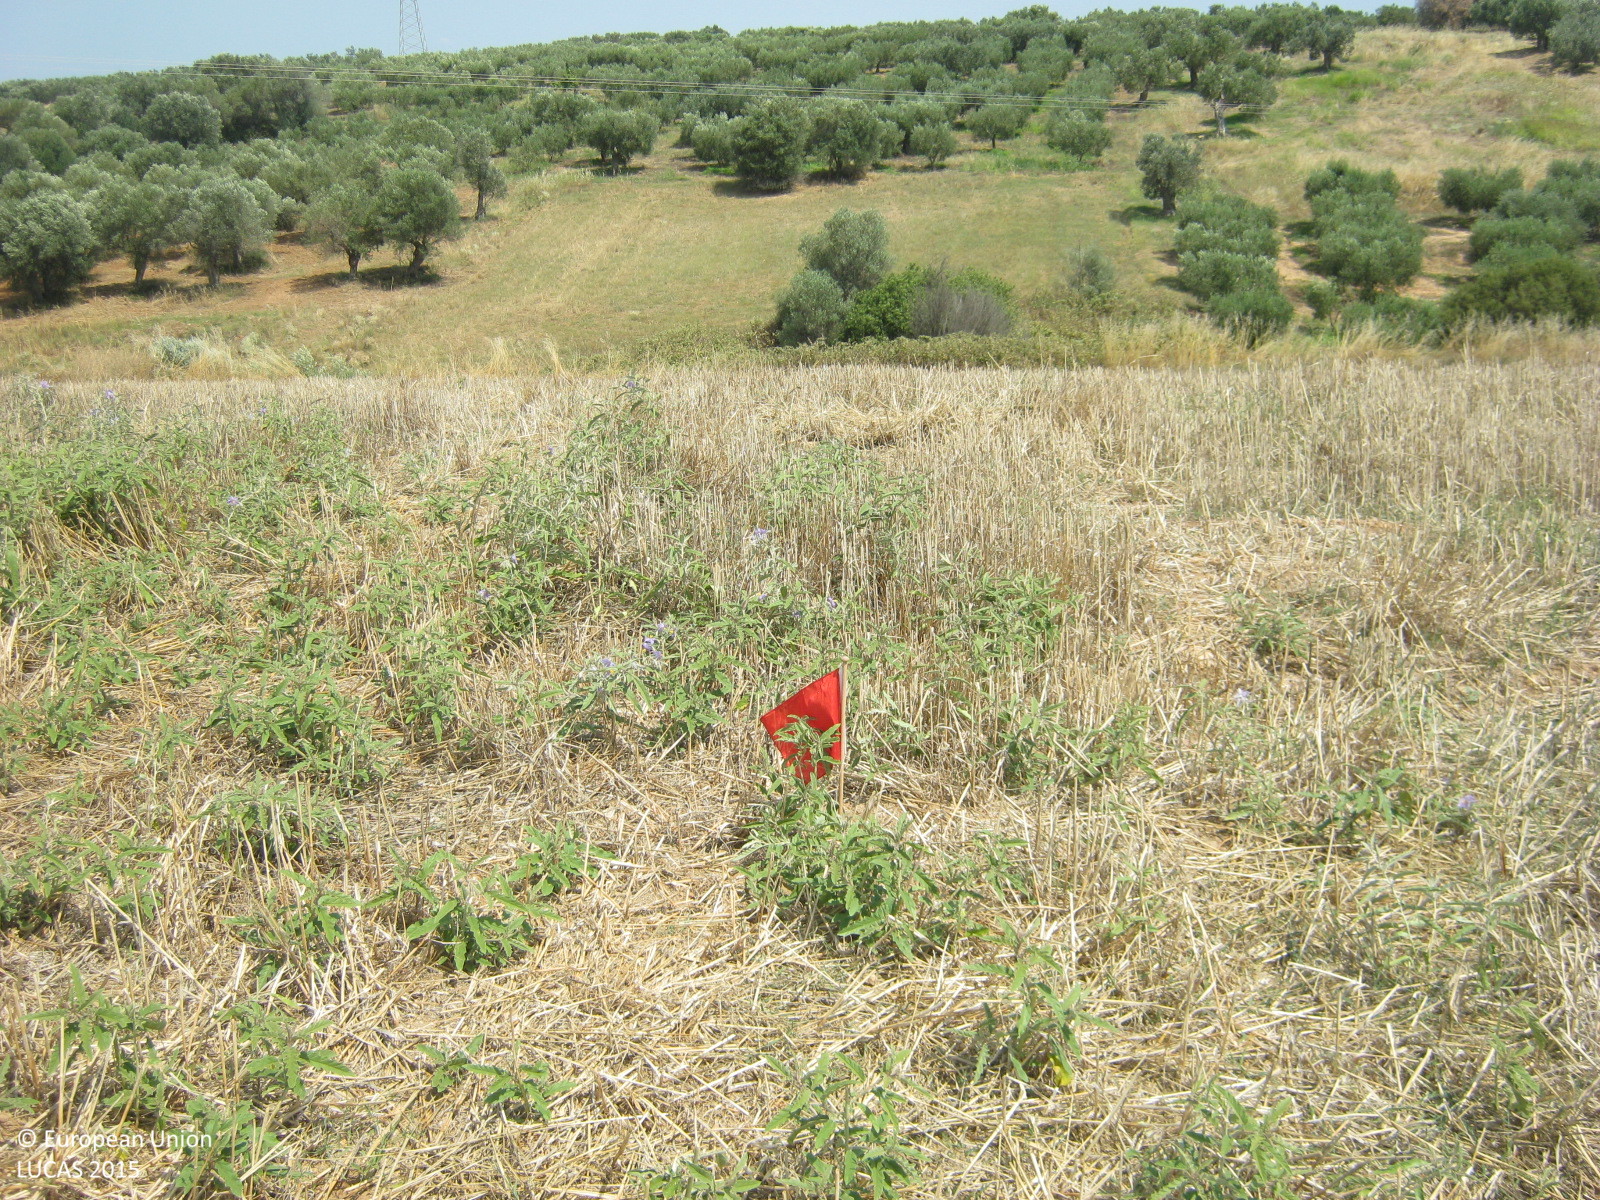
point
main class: Cropland
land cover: Common wheat
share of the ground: > 75 %
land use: Agriculture (excluding fallow land and kitchen gardens)
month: July
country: GR
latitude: 40.3429
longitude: 23.3227
